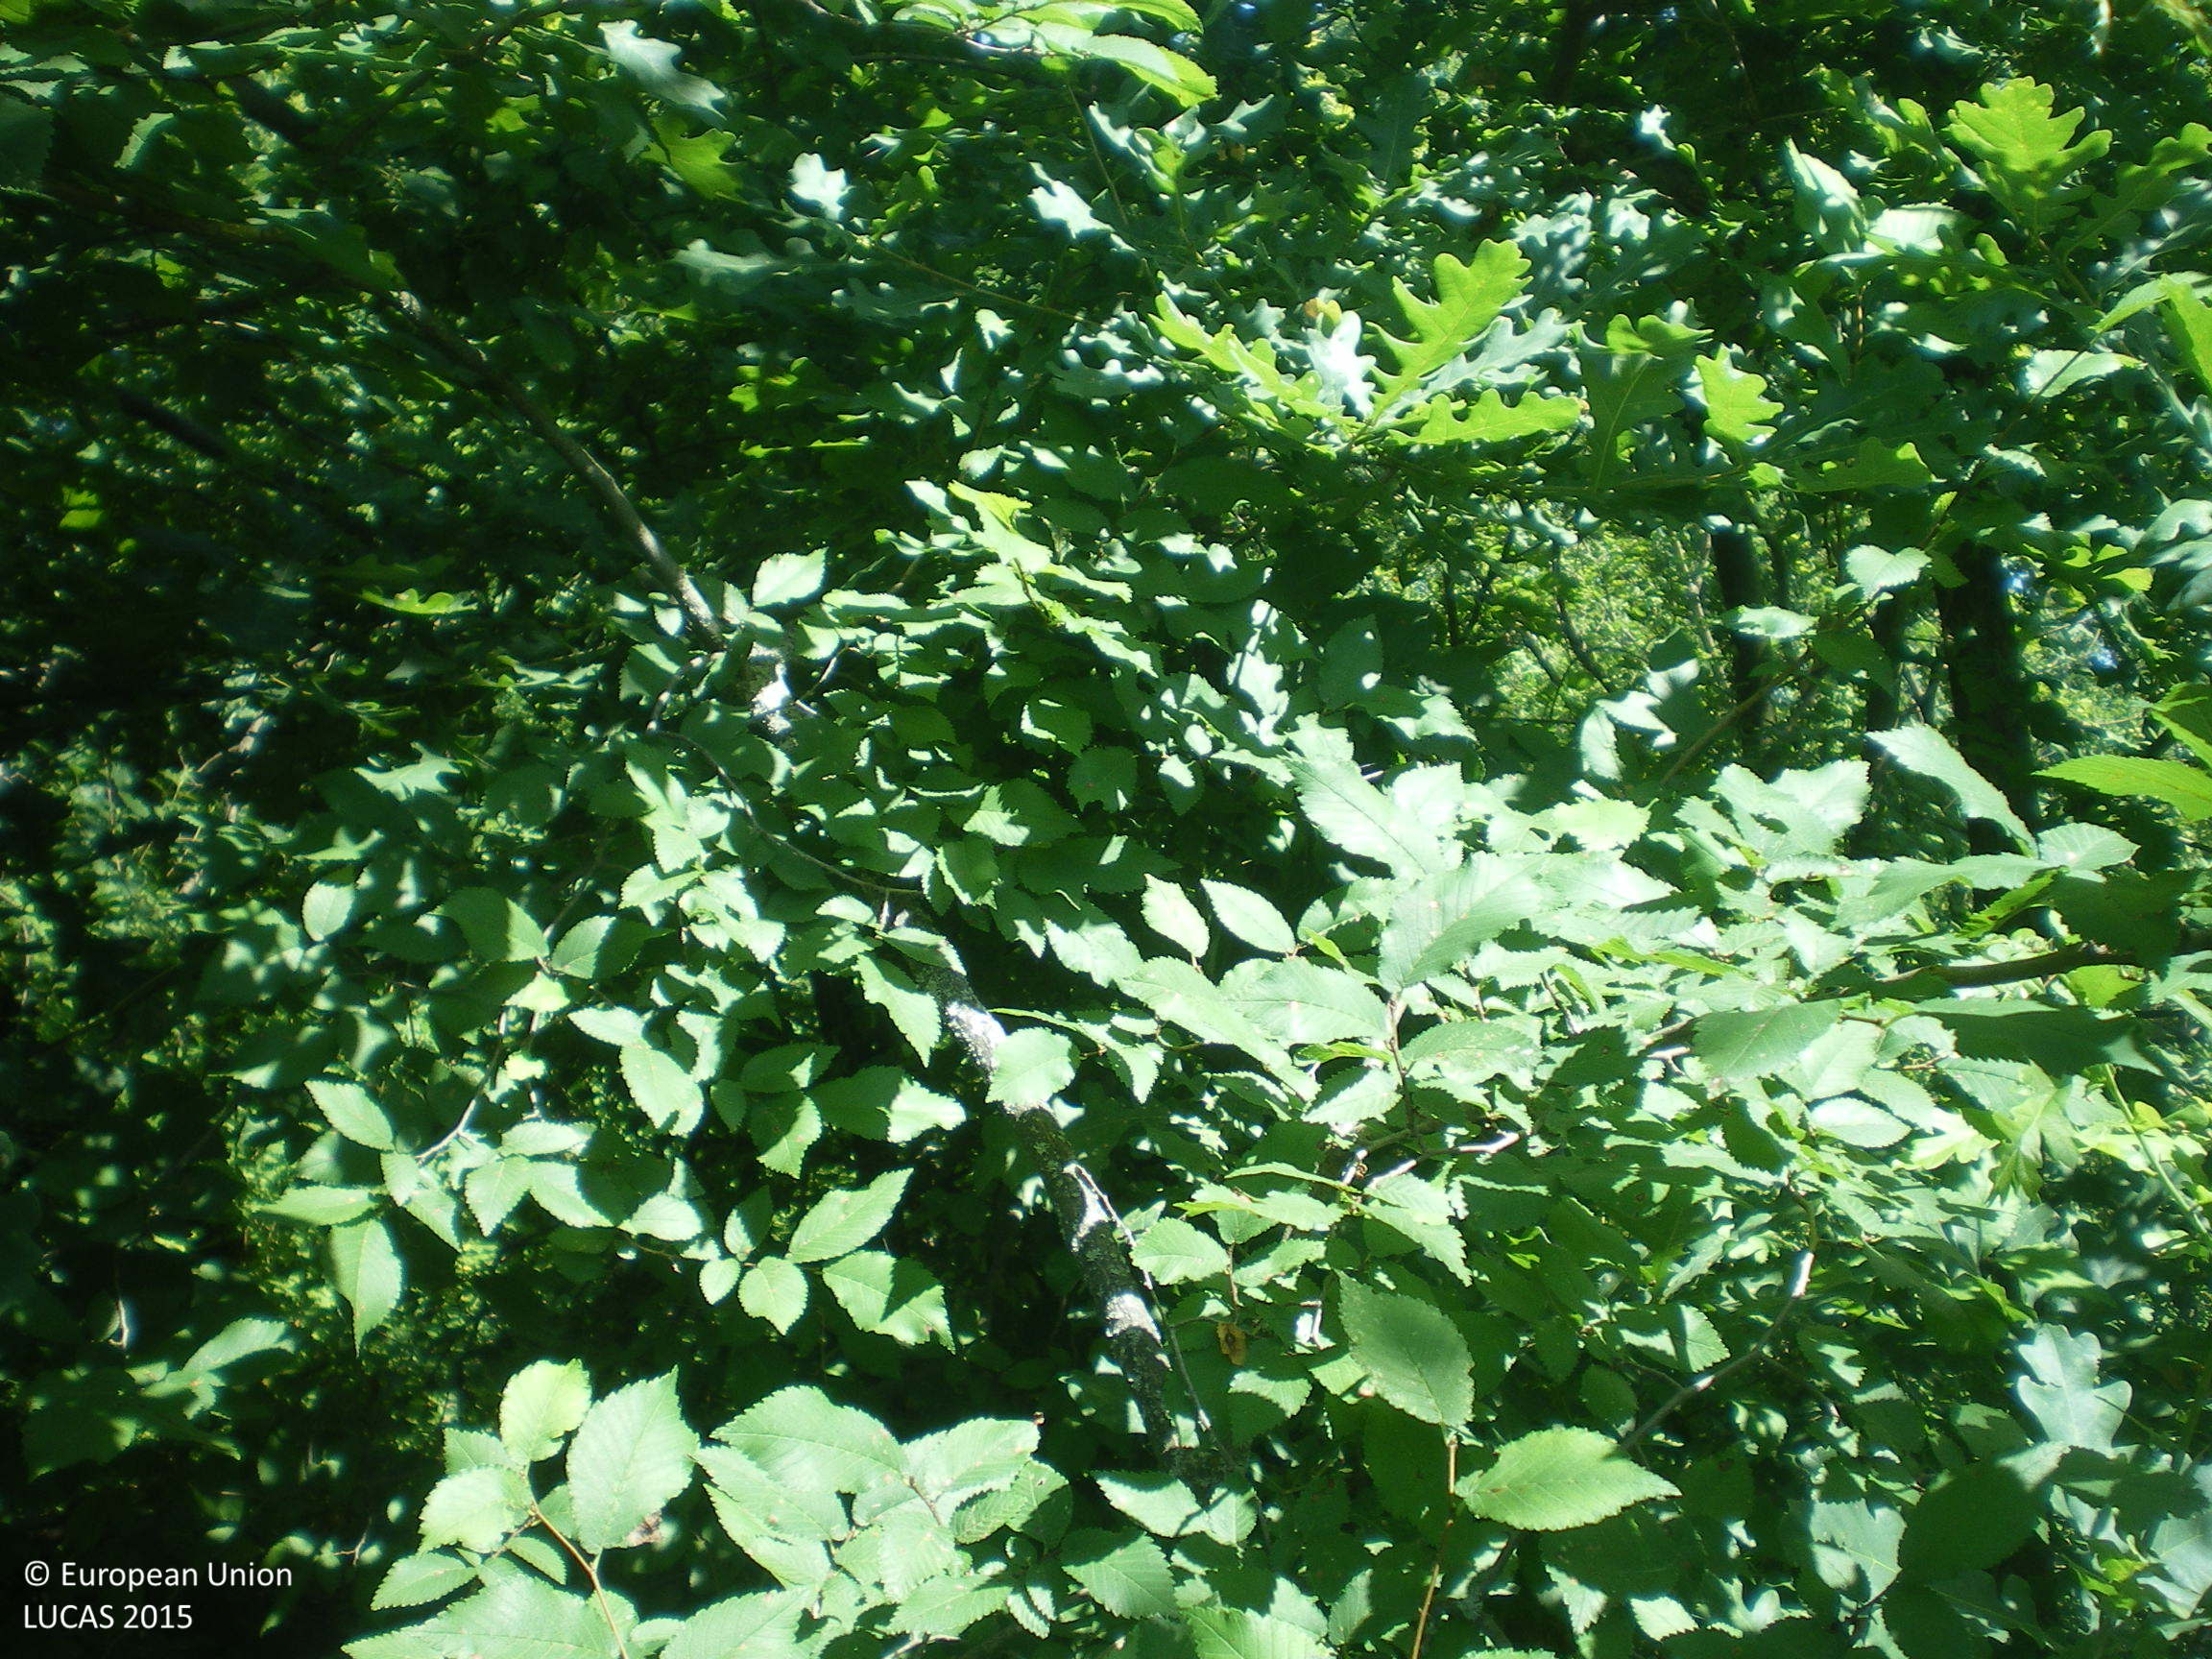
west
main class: Woodland
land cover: Broadleaved woodland
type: mesophytic deciduous forest
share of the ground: > 75 %
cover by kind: broadleaved forest trees 95 %, shrubs 5 %
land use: Forestry
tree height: > 5 m
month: July
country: BG
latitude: 42.4054
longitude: 25.8597
